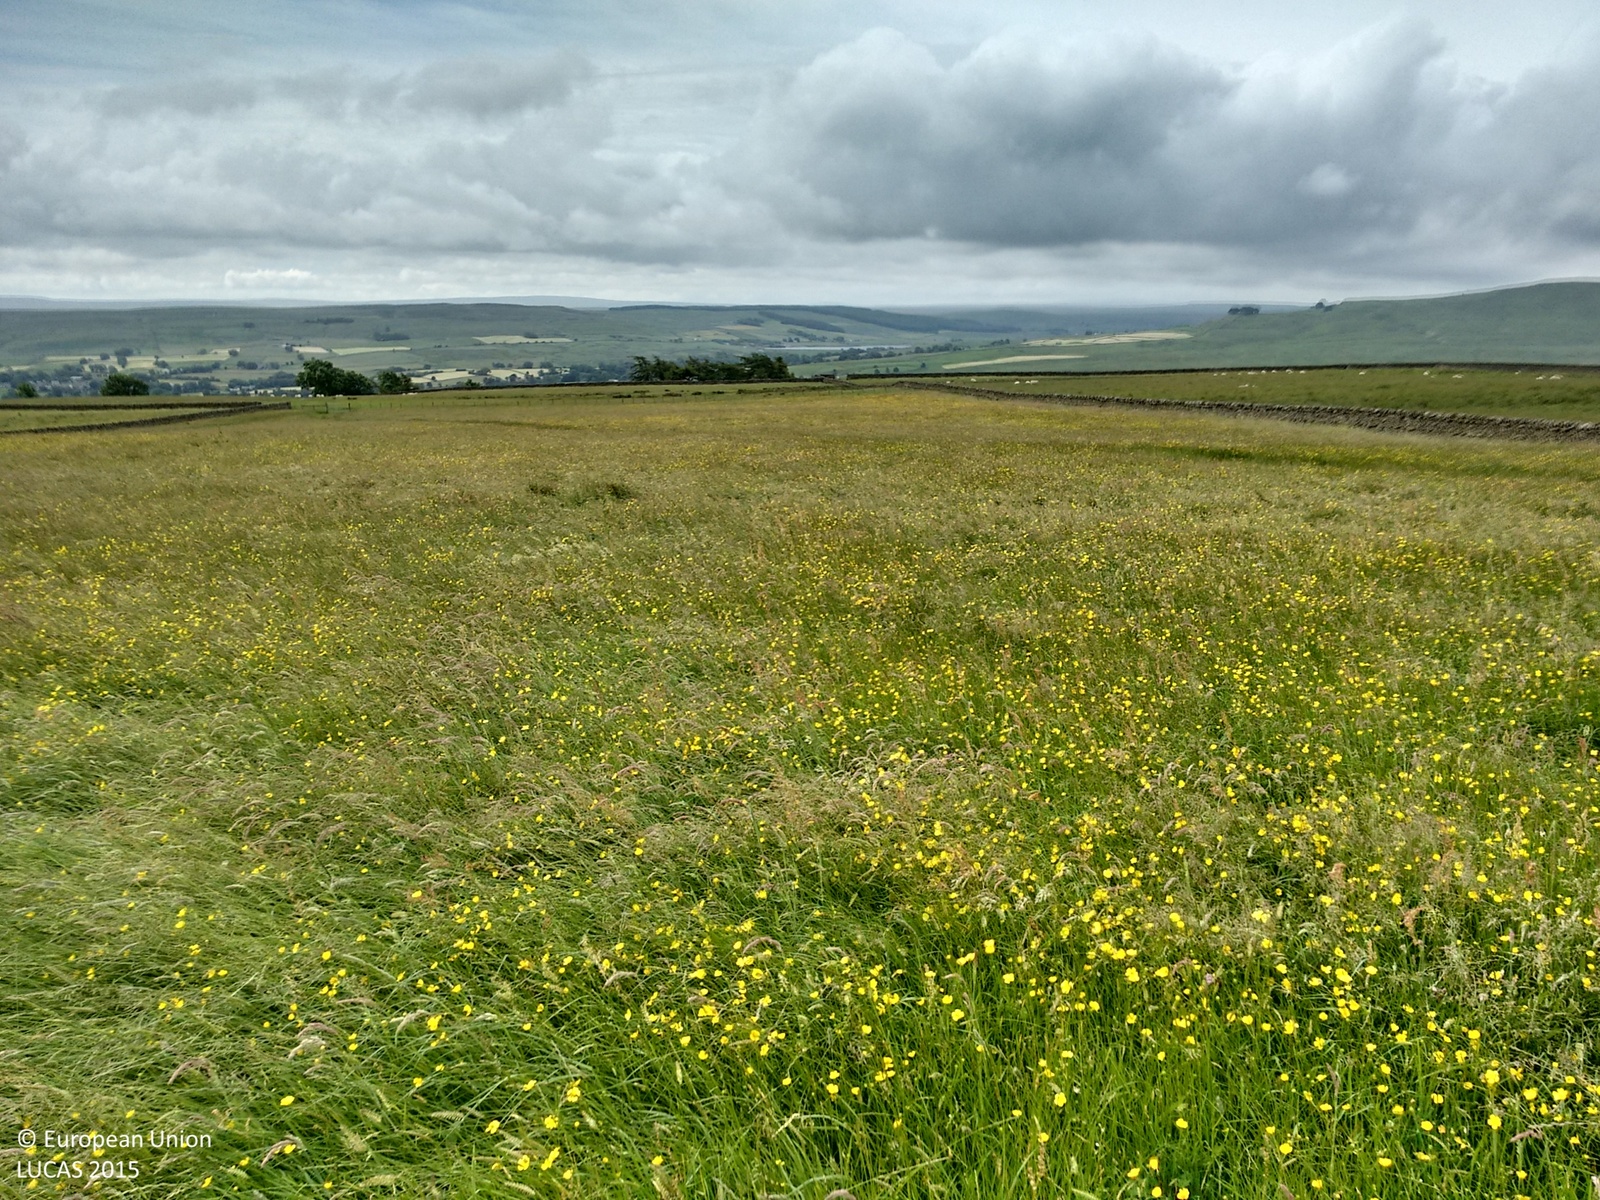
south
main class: Grassland
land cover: Grassland without tree/shrub cover
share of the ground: > 75 %
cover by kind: herbaceous plants 100 %
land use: Agriculture (excluding fallow land and kitchen gardens)
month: July
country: GB
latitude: 54.6335
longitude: -2.0627
